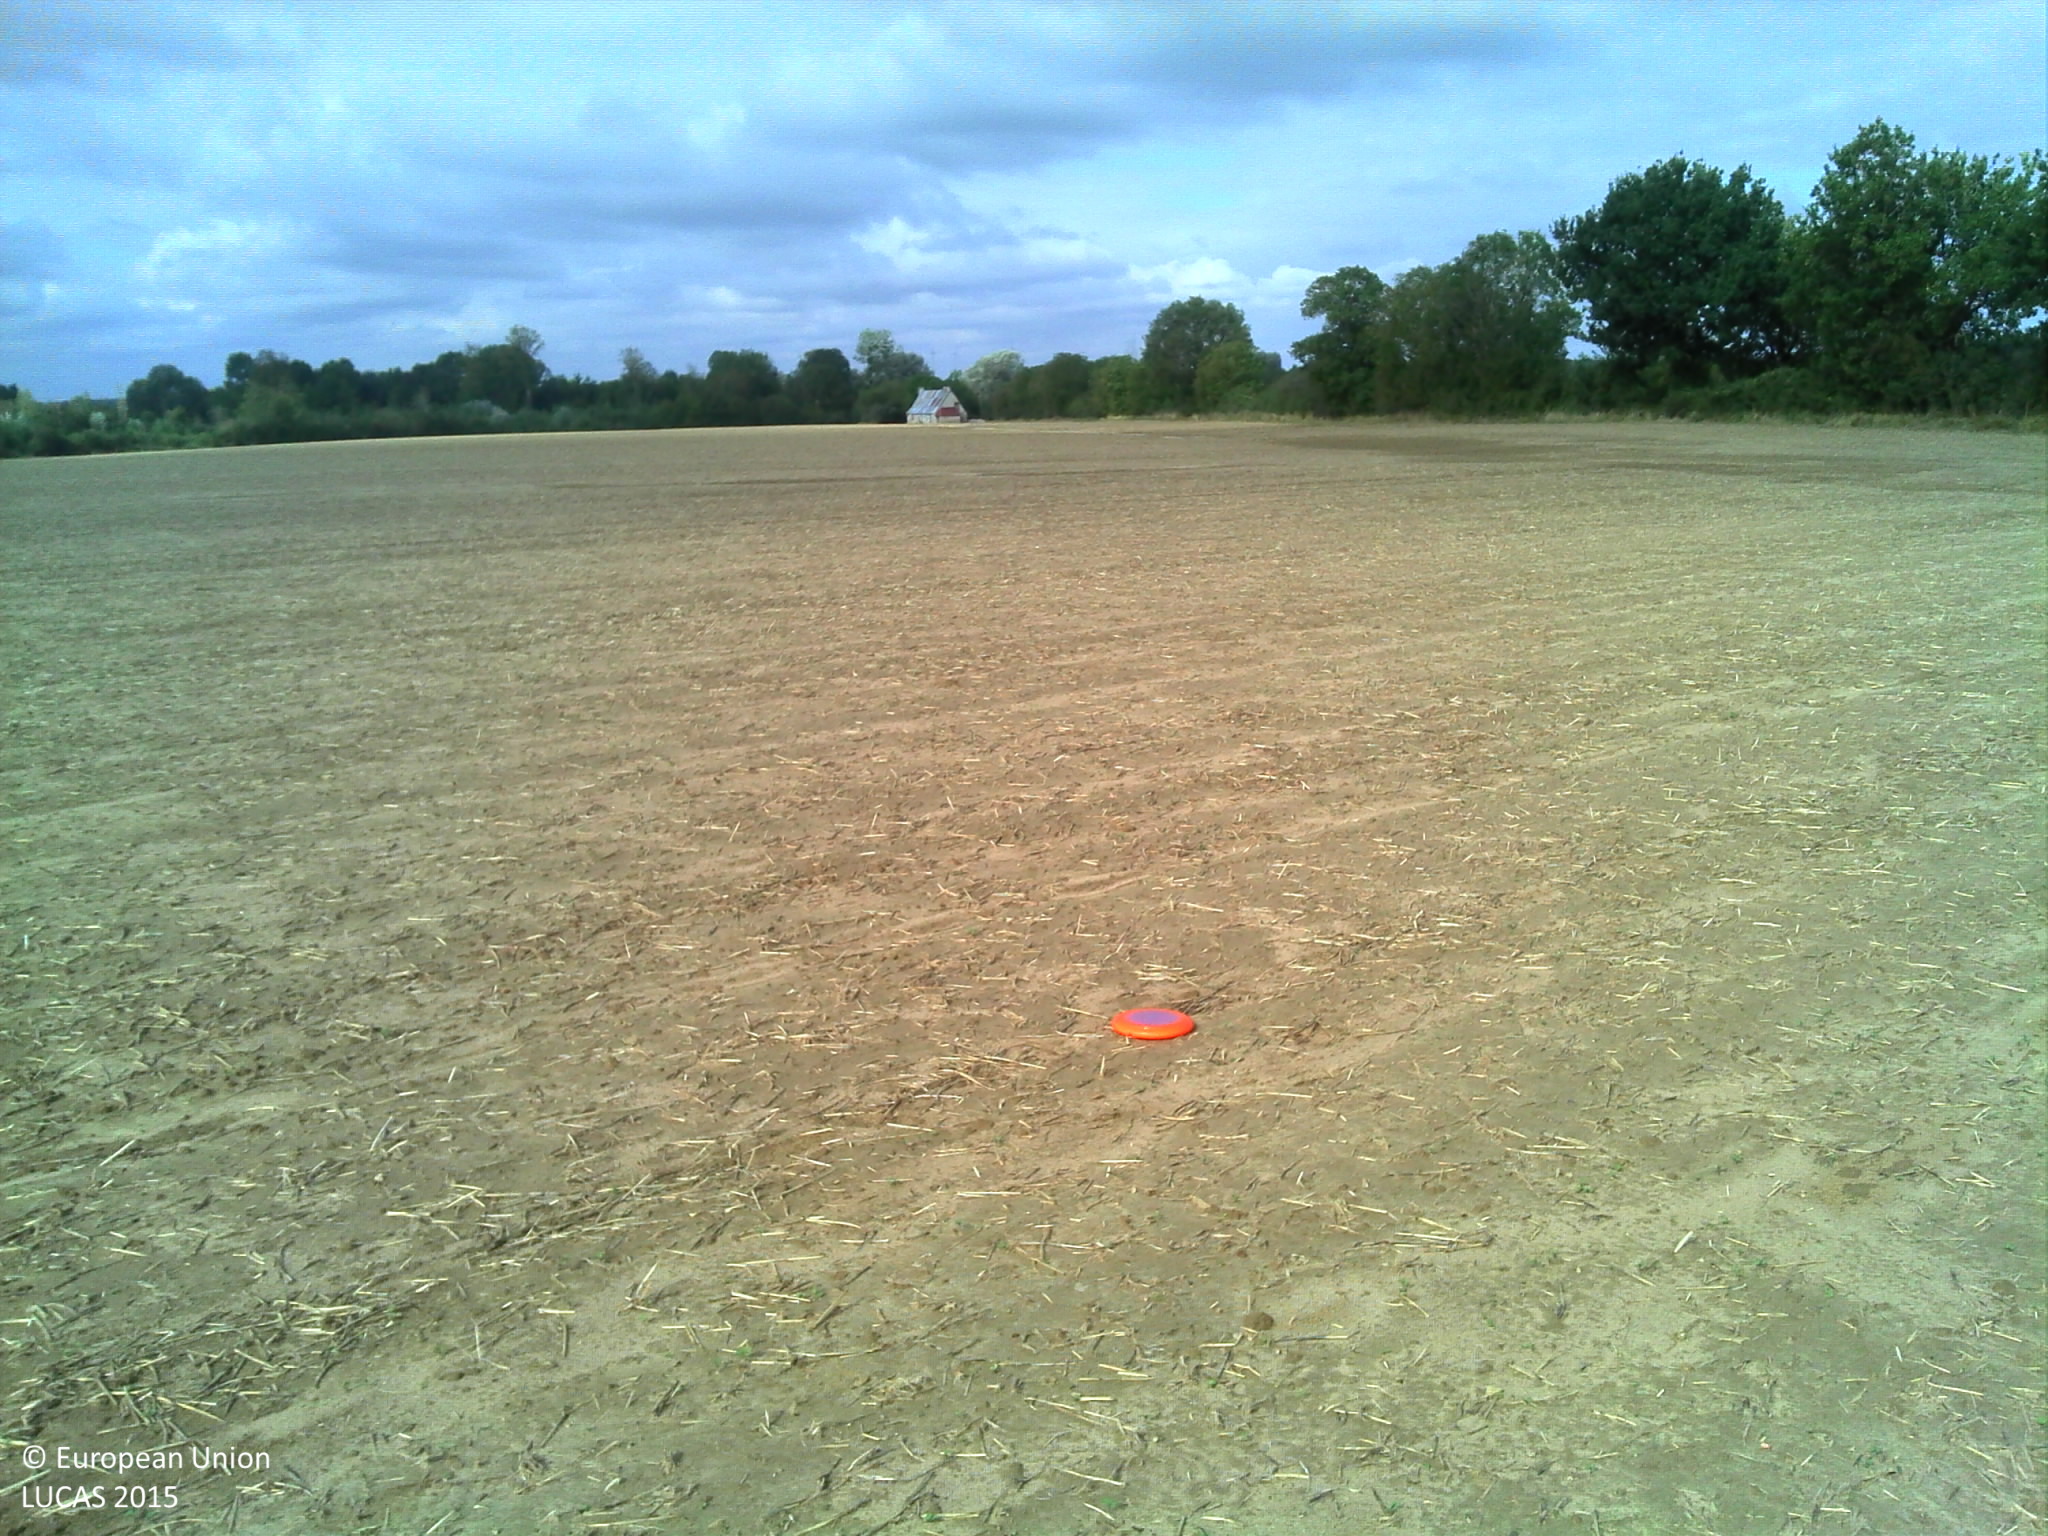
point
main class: Cropland
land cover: Other fibre and oleaginous crops
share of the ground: < 10 %
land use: Agriculture (excluding fallow land and kitchen gardens)
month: September
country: FR
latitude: 46.9129
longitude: 1.4403
